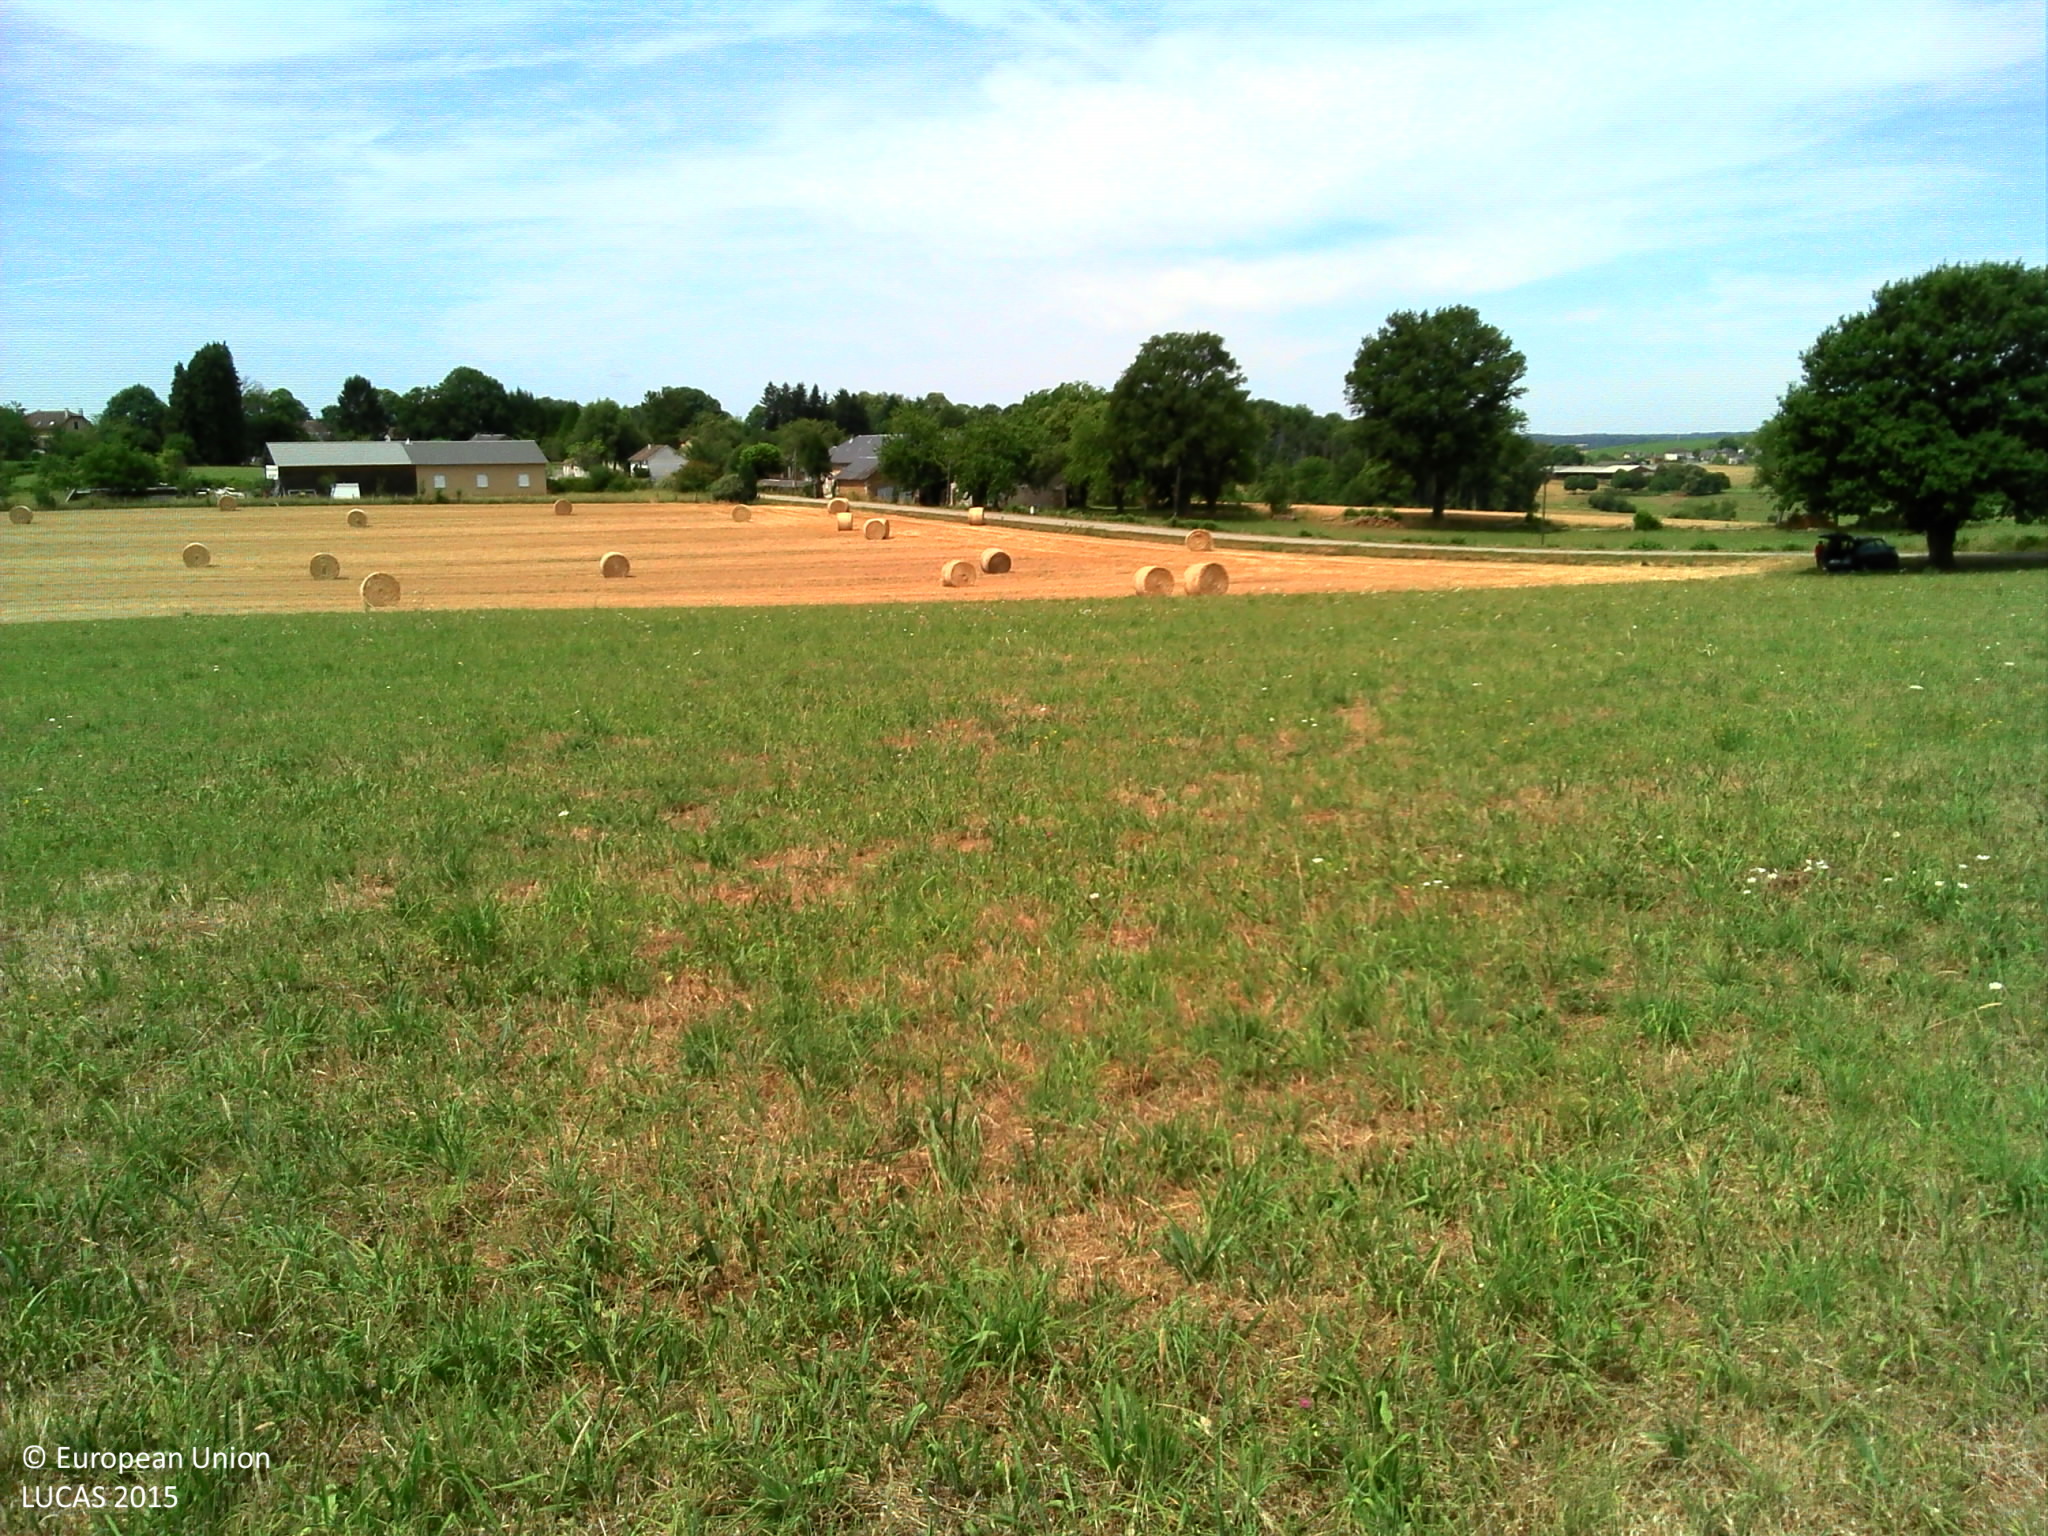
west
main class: Cropland
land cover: Temporary grasslands
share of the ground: > 75 %
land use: Agriculture (excluding fallow land and kitchen gardens)
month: July
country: FR
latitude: 45.7328
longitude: 1.6276
